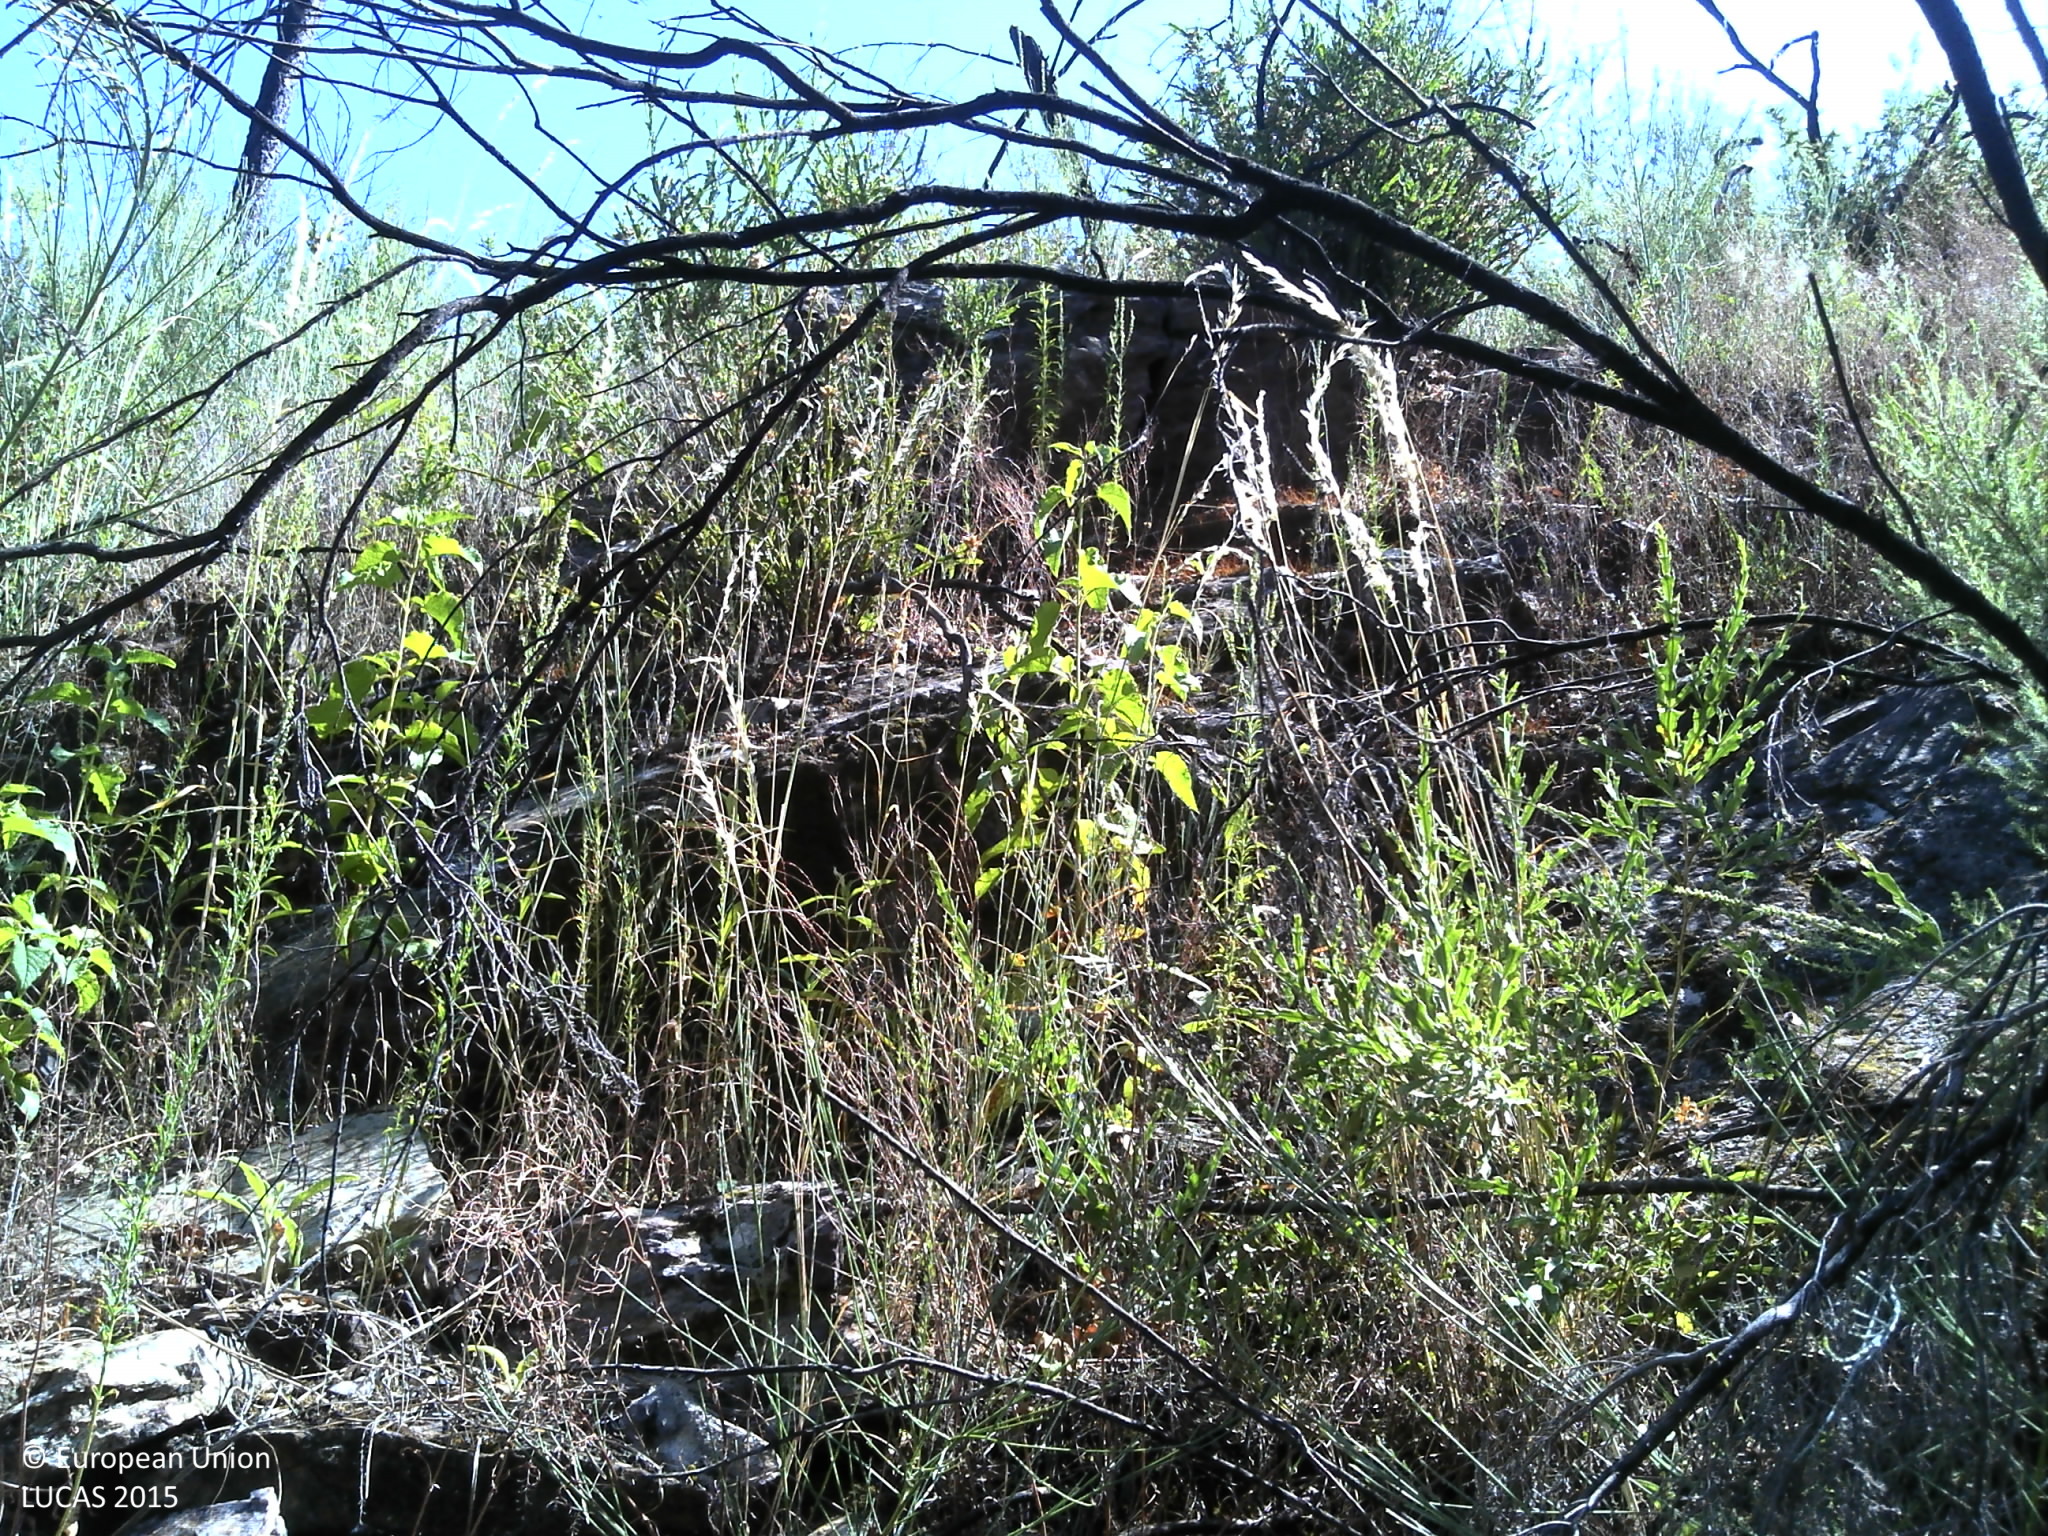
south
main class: Woodland
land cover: Pine dominated coniferous woodland
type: coniferous forest of the mediterranean region
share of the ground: < 10 %
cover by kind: shrubs 80 %, coniferous forest trees 10 %, herbaceous plants 5 %, unconsolidated bare surface 5 %
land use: Abandoned areas
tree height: > 5 m
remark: Burnt area
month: June
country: PT
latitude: 41.2001
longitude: -6.8119
